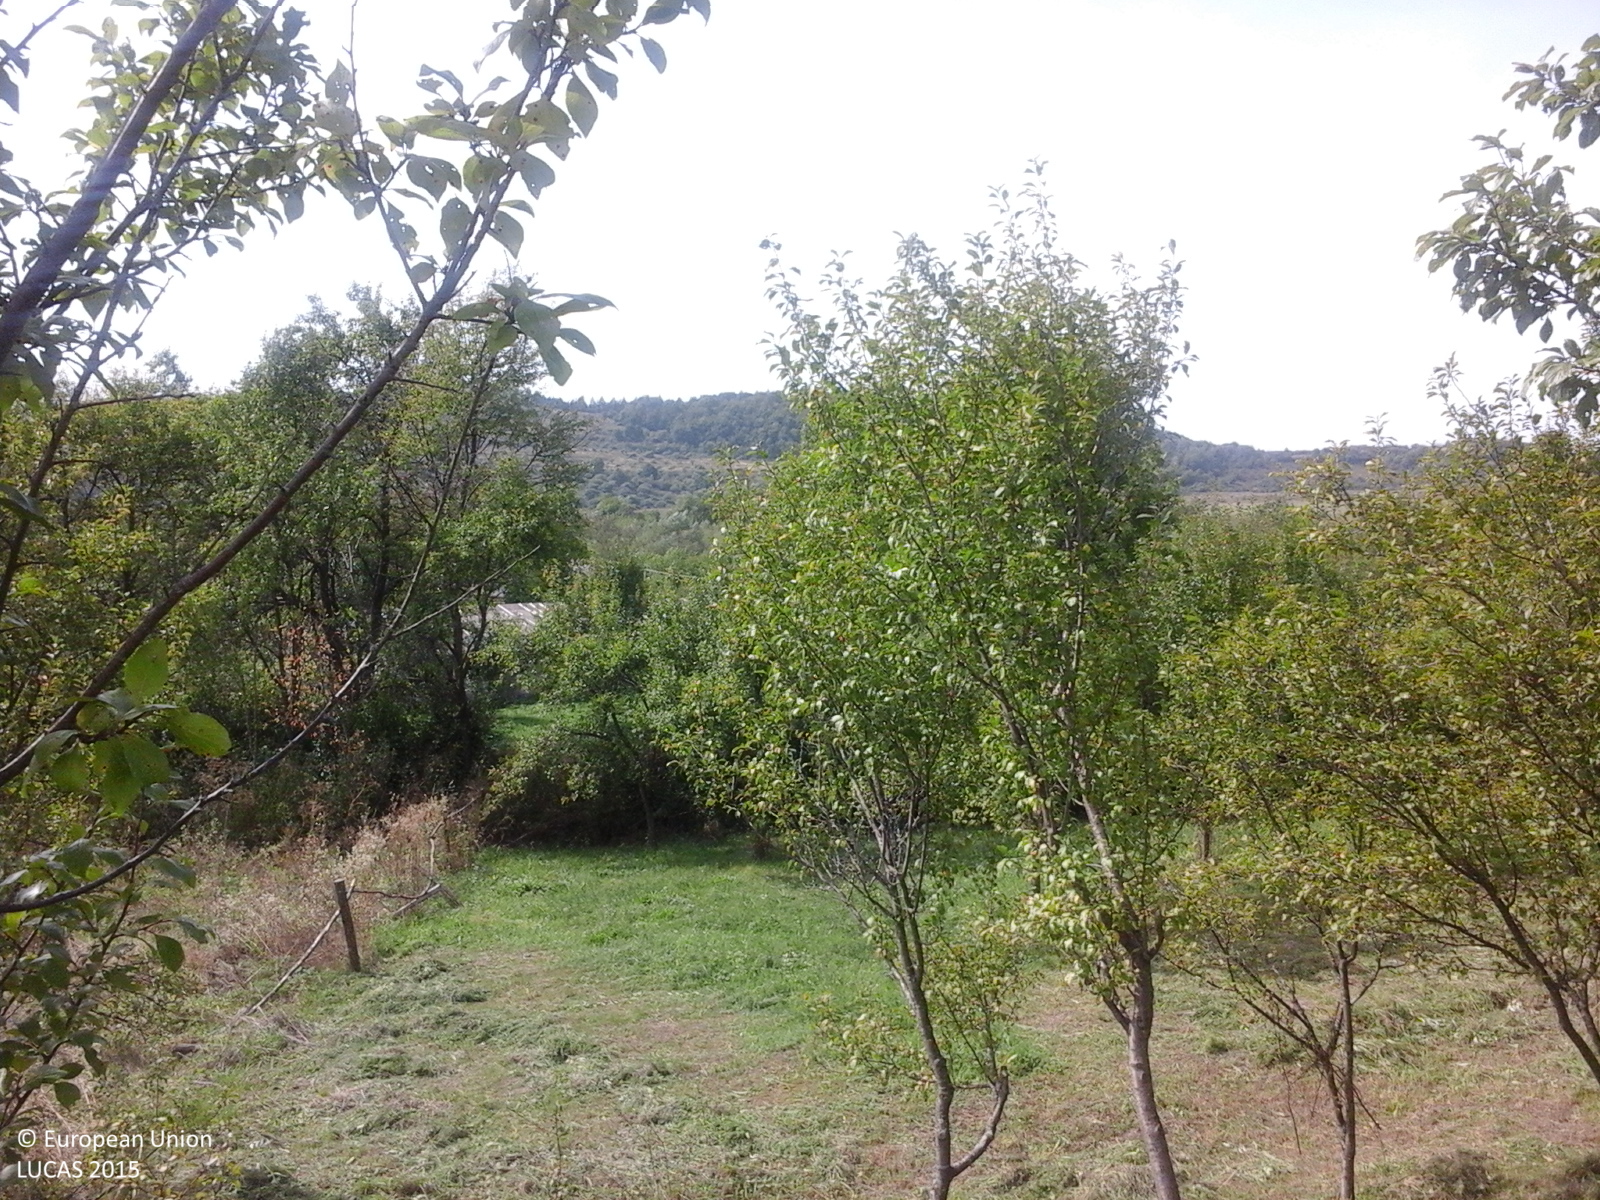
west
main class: Cropland
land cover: Other fruit trees and berries
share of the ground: > 75 %
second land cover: Grassland without tree/shrub cover
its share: > 75 %
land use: Agriculture (excluding fallow land and kitchen gardens)
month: September
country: RO
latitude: 47.2413
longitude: 23.9384
